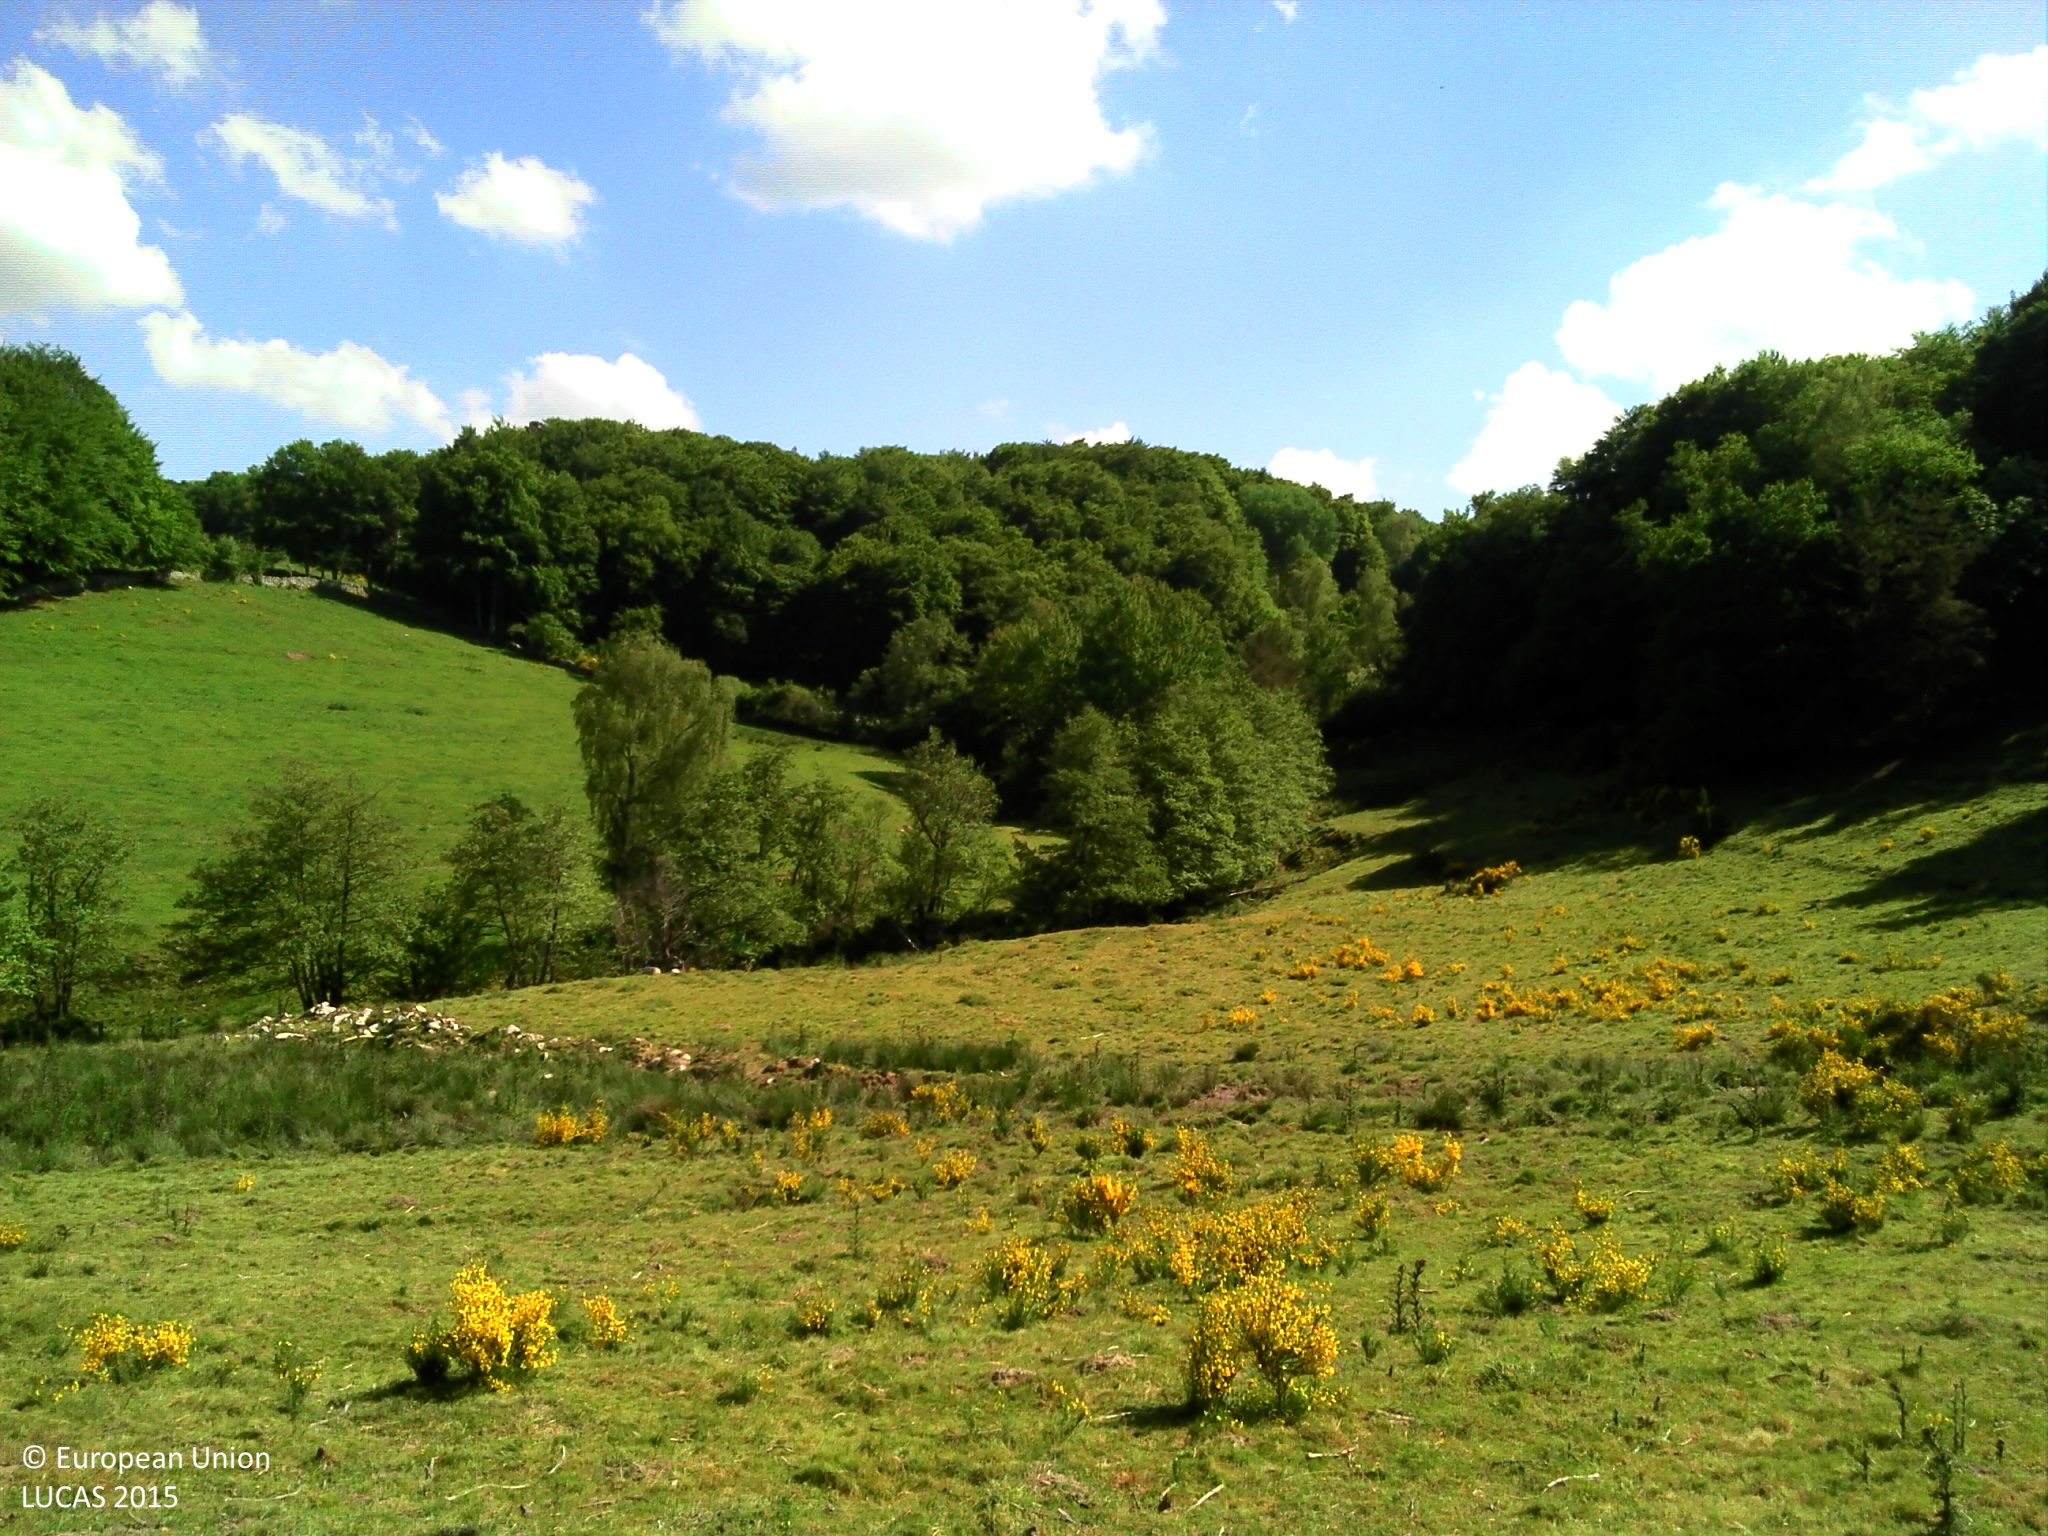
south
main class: Grassland
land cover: Grassland with sparse tree/shrub cover
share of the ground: > 75 %
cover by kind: herbaceous plants 90 %, broadleaved forest trees 5 %, shrubs 5 %
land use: Agriculture (excluding fallow land and kitchen gardens)
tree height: < 5 m
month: June
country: FR
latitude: 44.8204
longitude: 3.0094
